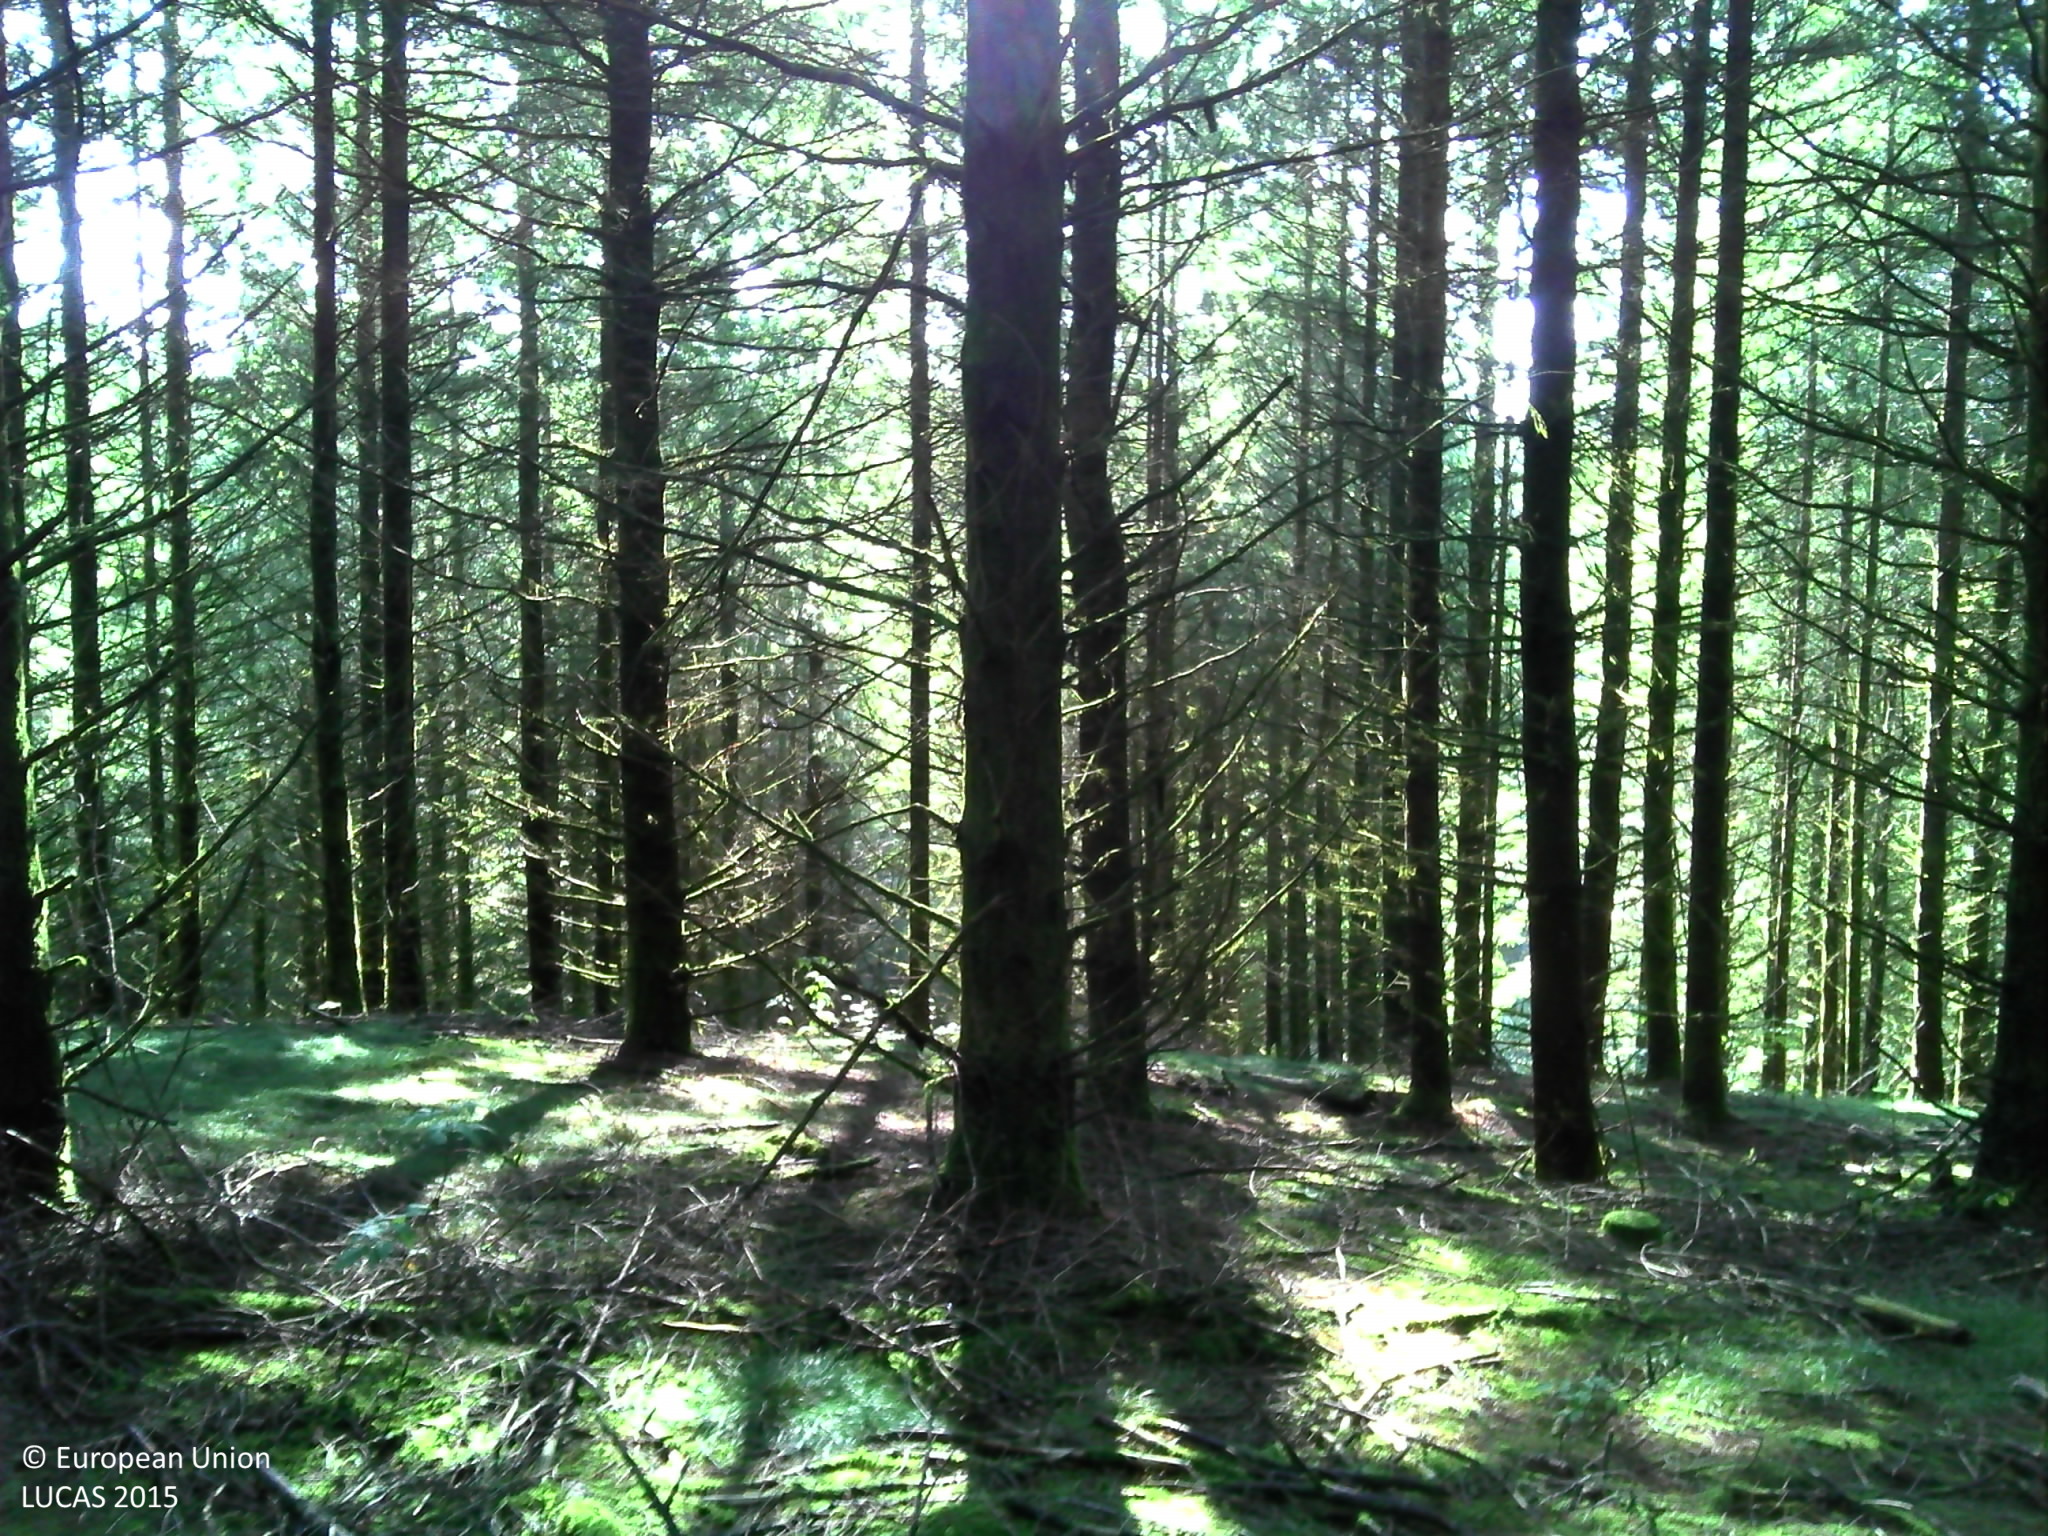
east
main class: Woodland
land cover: Spruce dominated coniferous woodland
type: exotic forest
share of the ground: > 75 %
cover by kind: coniferous forest trees 70 %, herbaceous plants 30 %
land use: Forestry
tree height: > 5 m
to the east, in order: Spruce dominated coniferous woodland
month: August
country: FR
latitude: 45.5341
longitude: 1.8640
